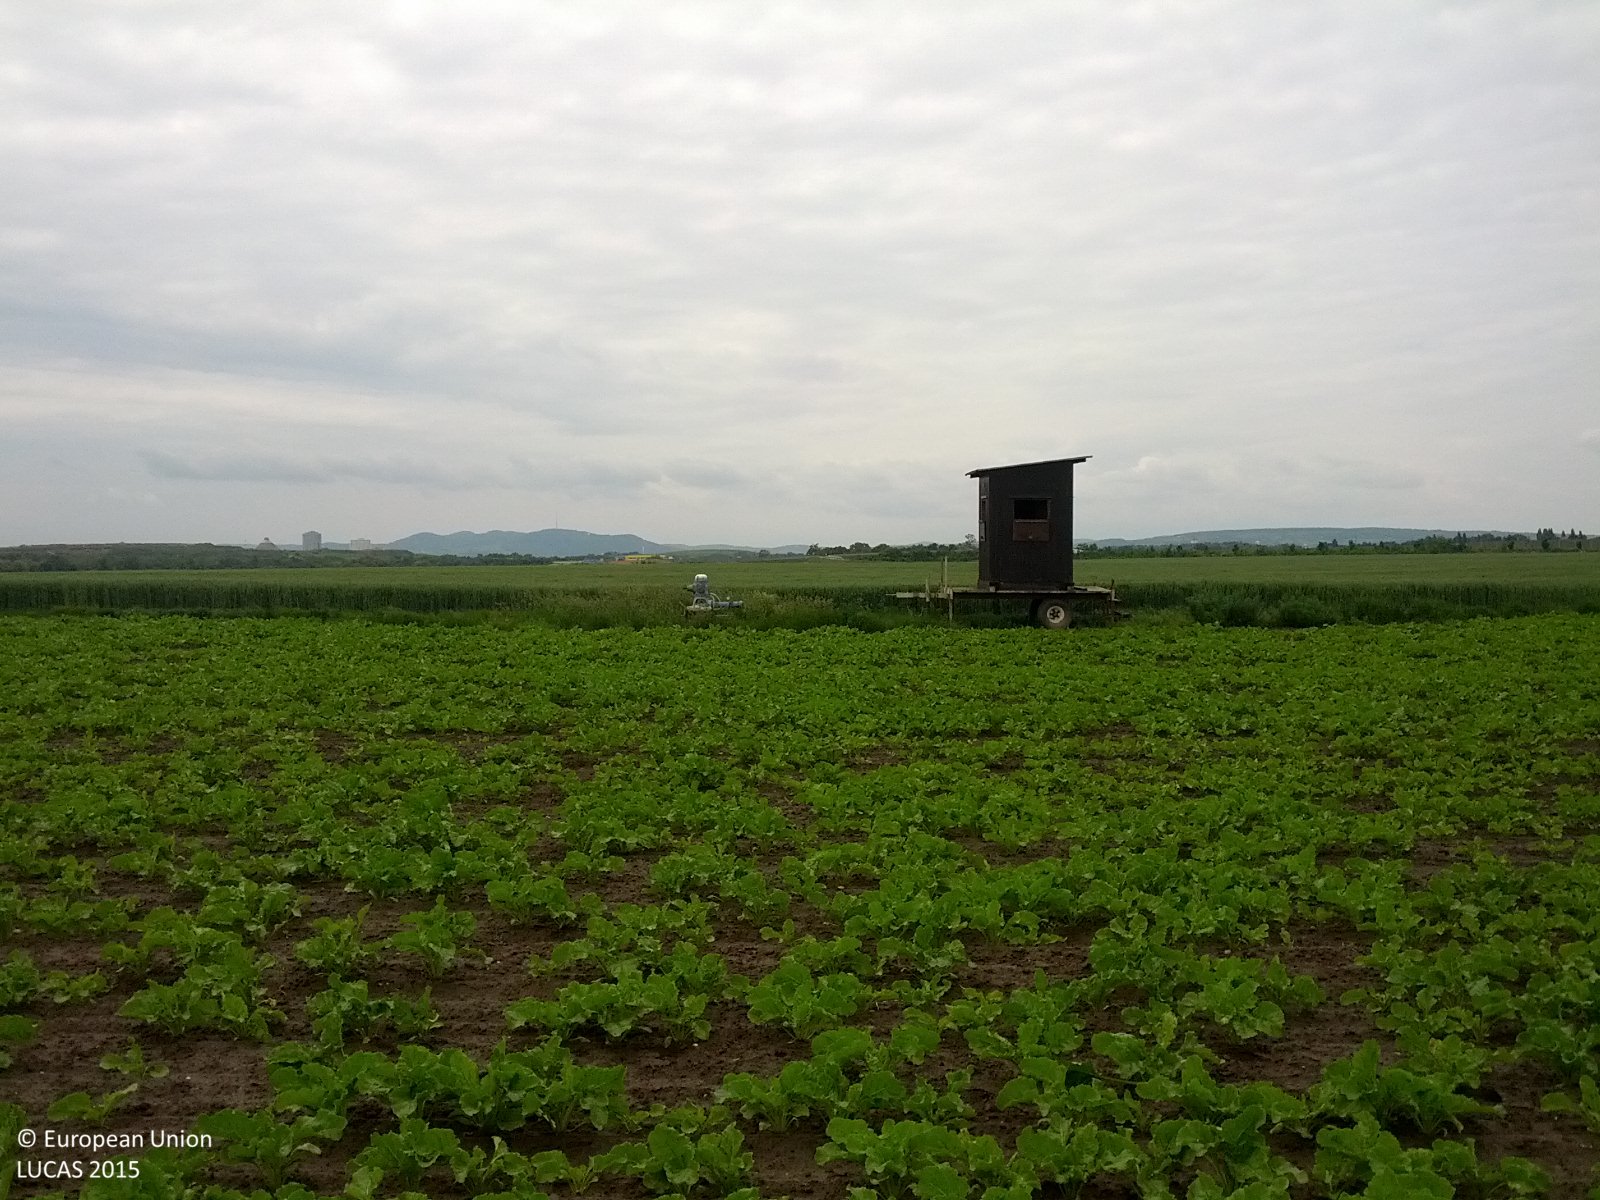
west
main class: Cropland
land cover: Sugar beet
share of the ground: 50 - 75 %
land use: Agriculture (excluding fallow land and kitchen gardens)
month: May
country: AT
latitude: 48.2656
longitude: 16.5125
